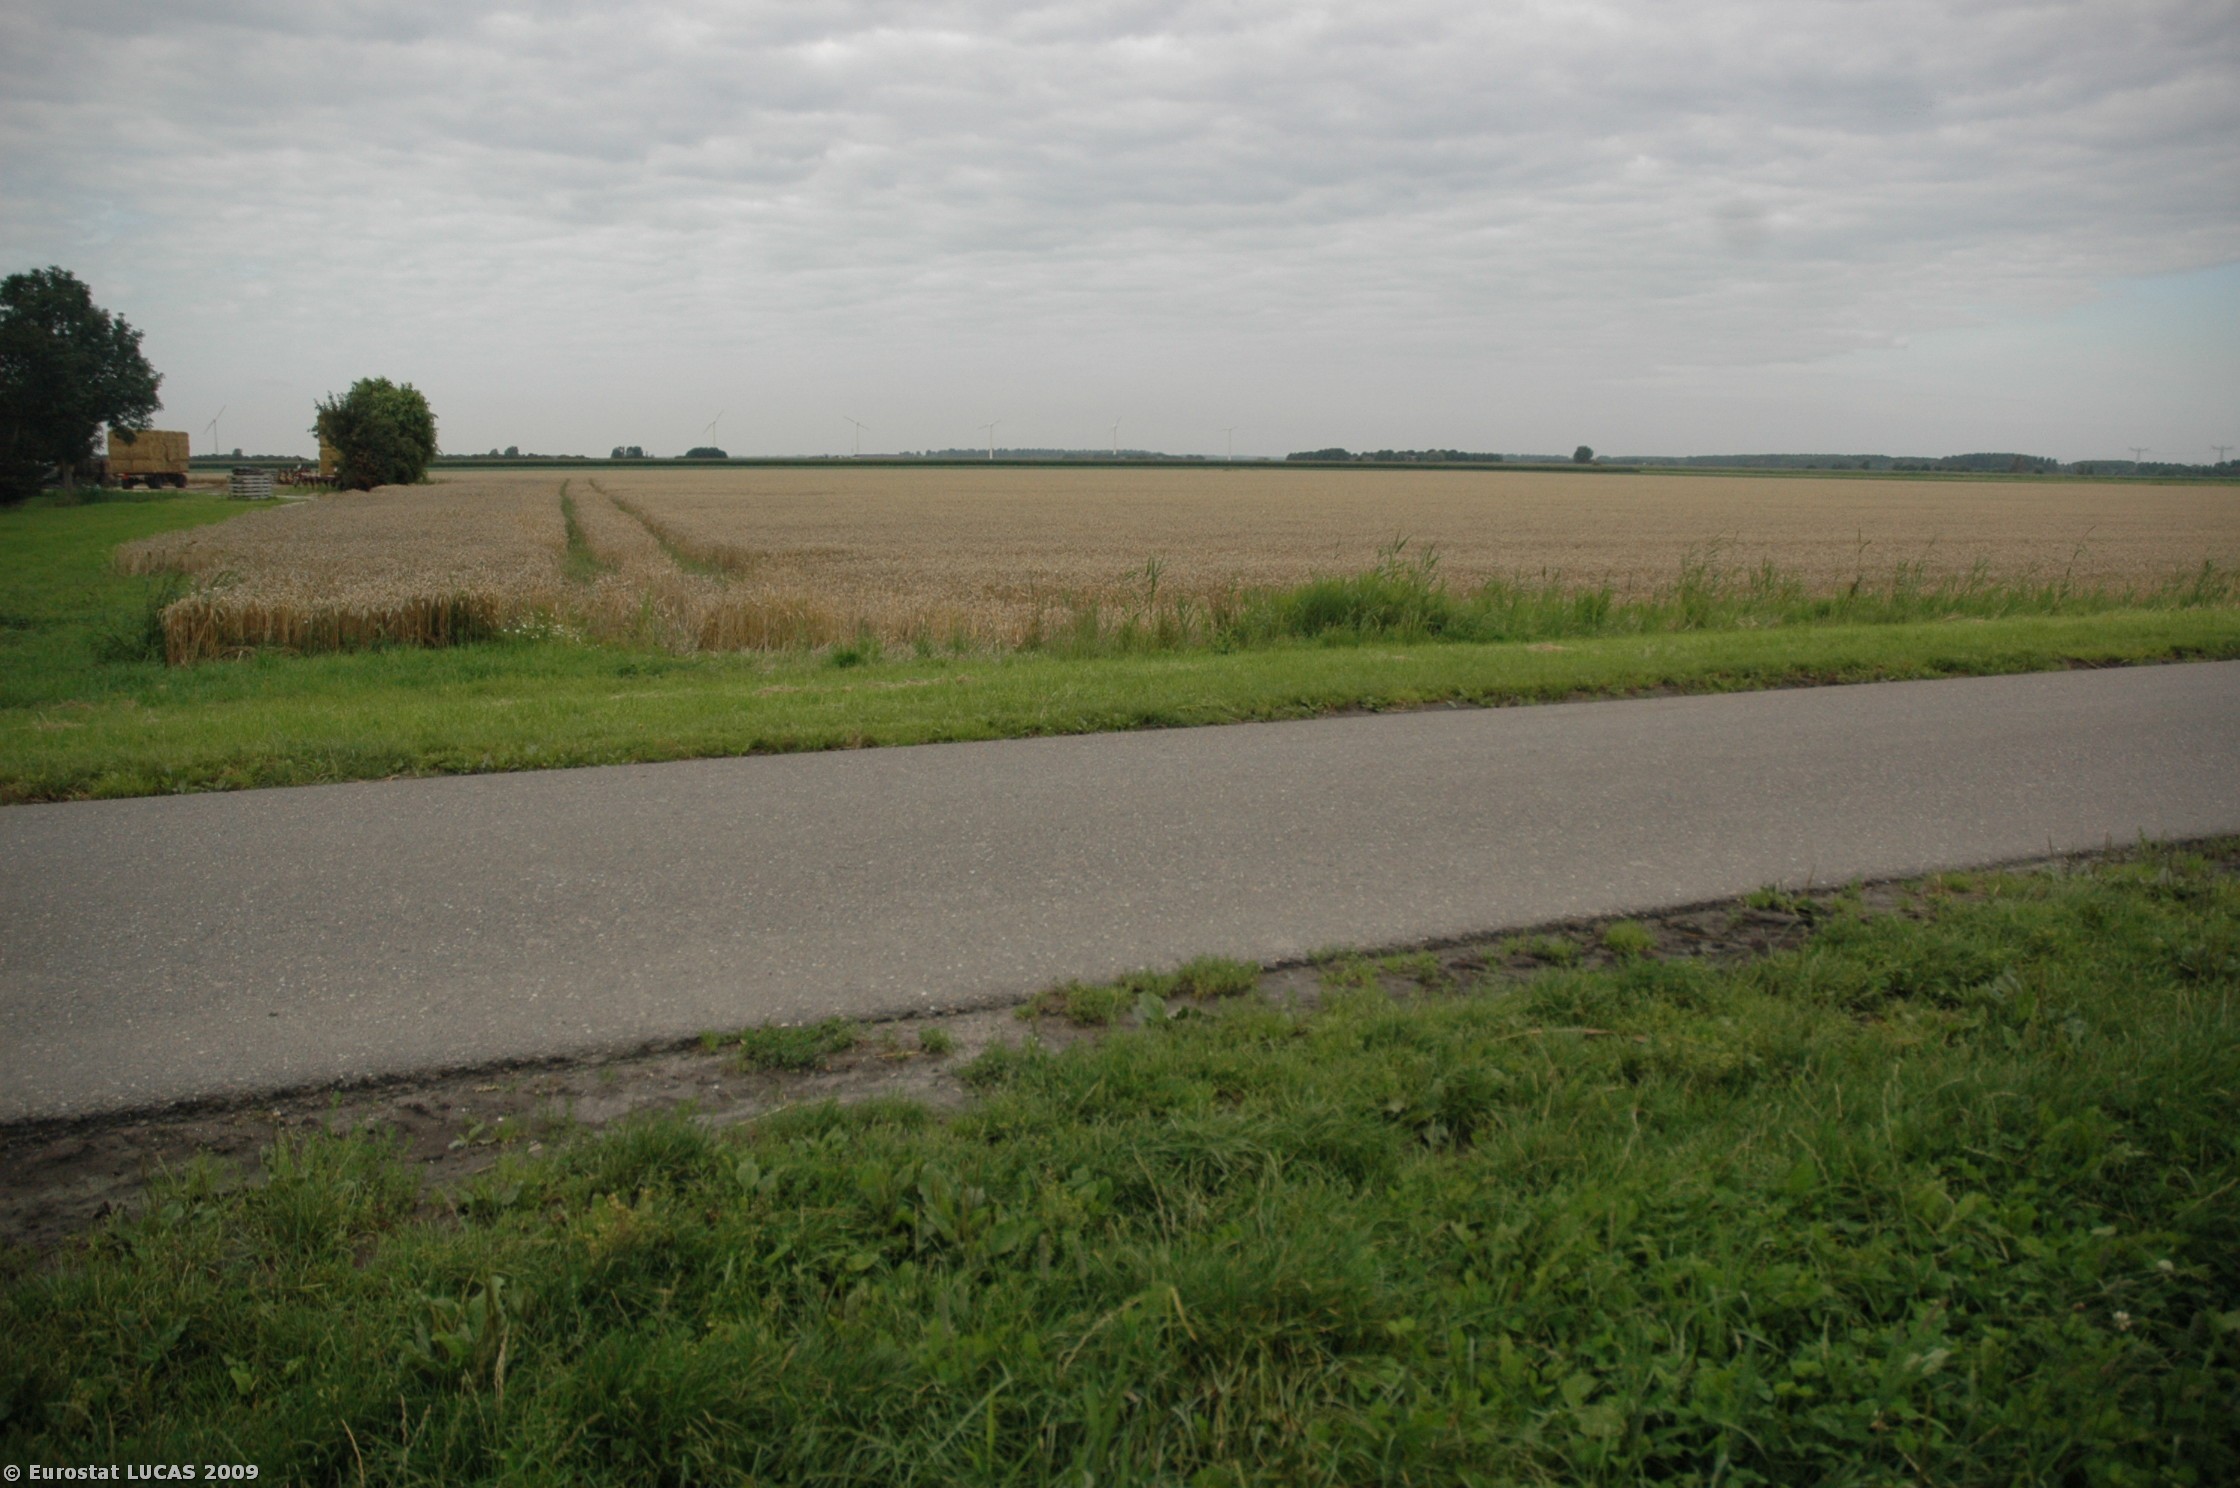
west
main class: Grassland
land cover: Grassland without tree/shrub cover
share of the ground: > 75 %
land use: Agriculture (excluding fallow land and kitchen gardens)
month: August
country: NL
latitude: 52.3055
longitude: 5.3783
